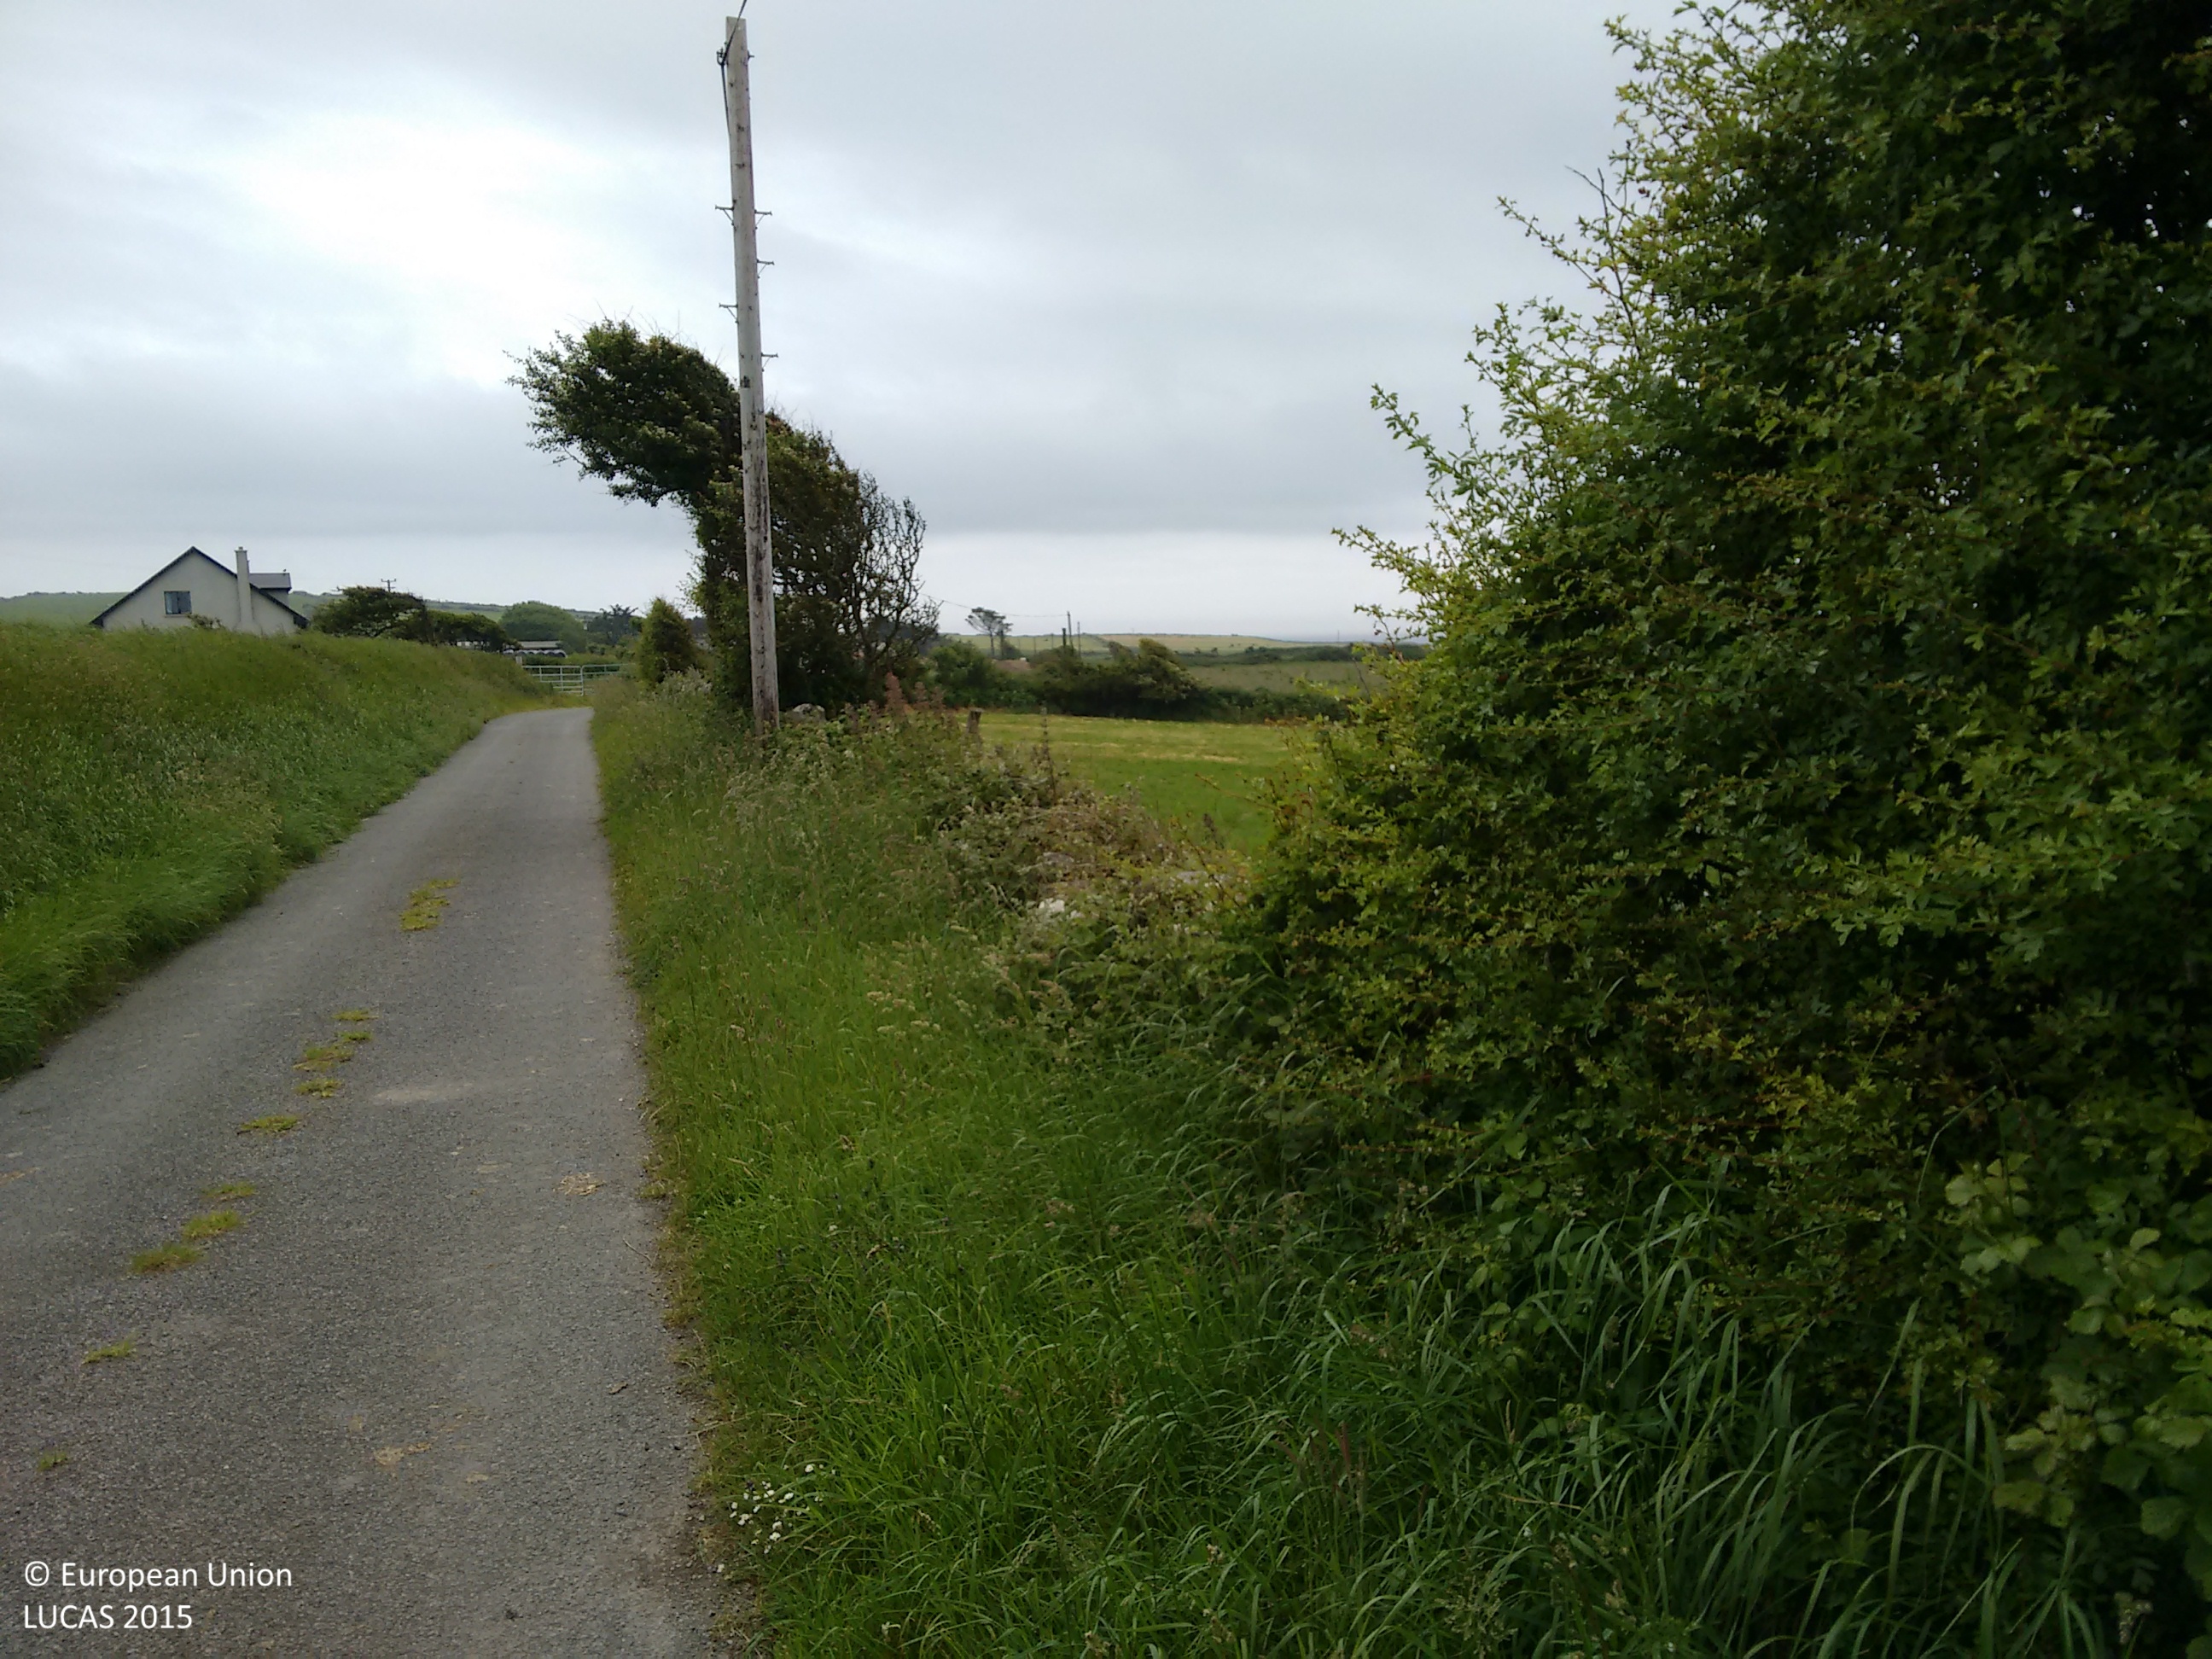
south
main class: Grassland
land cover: Grassland without tree/shrub cover
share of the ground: > 75 %
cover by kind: herbaceous plants 100 %
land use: Agriculture (excluding fallow land and kitchen gardens)
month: June
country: IE
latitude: 52.1477
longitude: -7.2645
